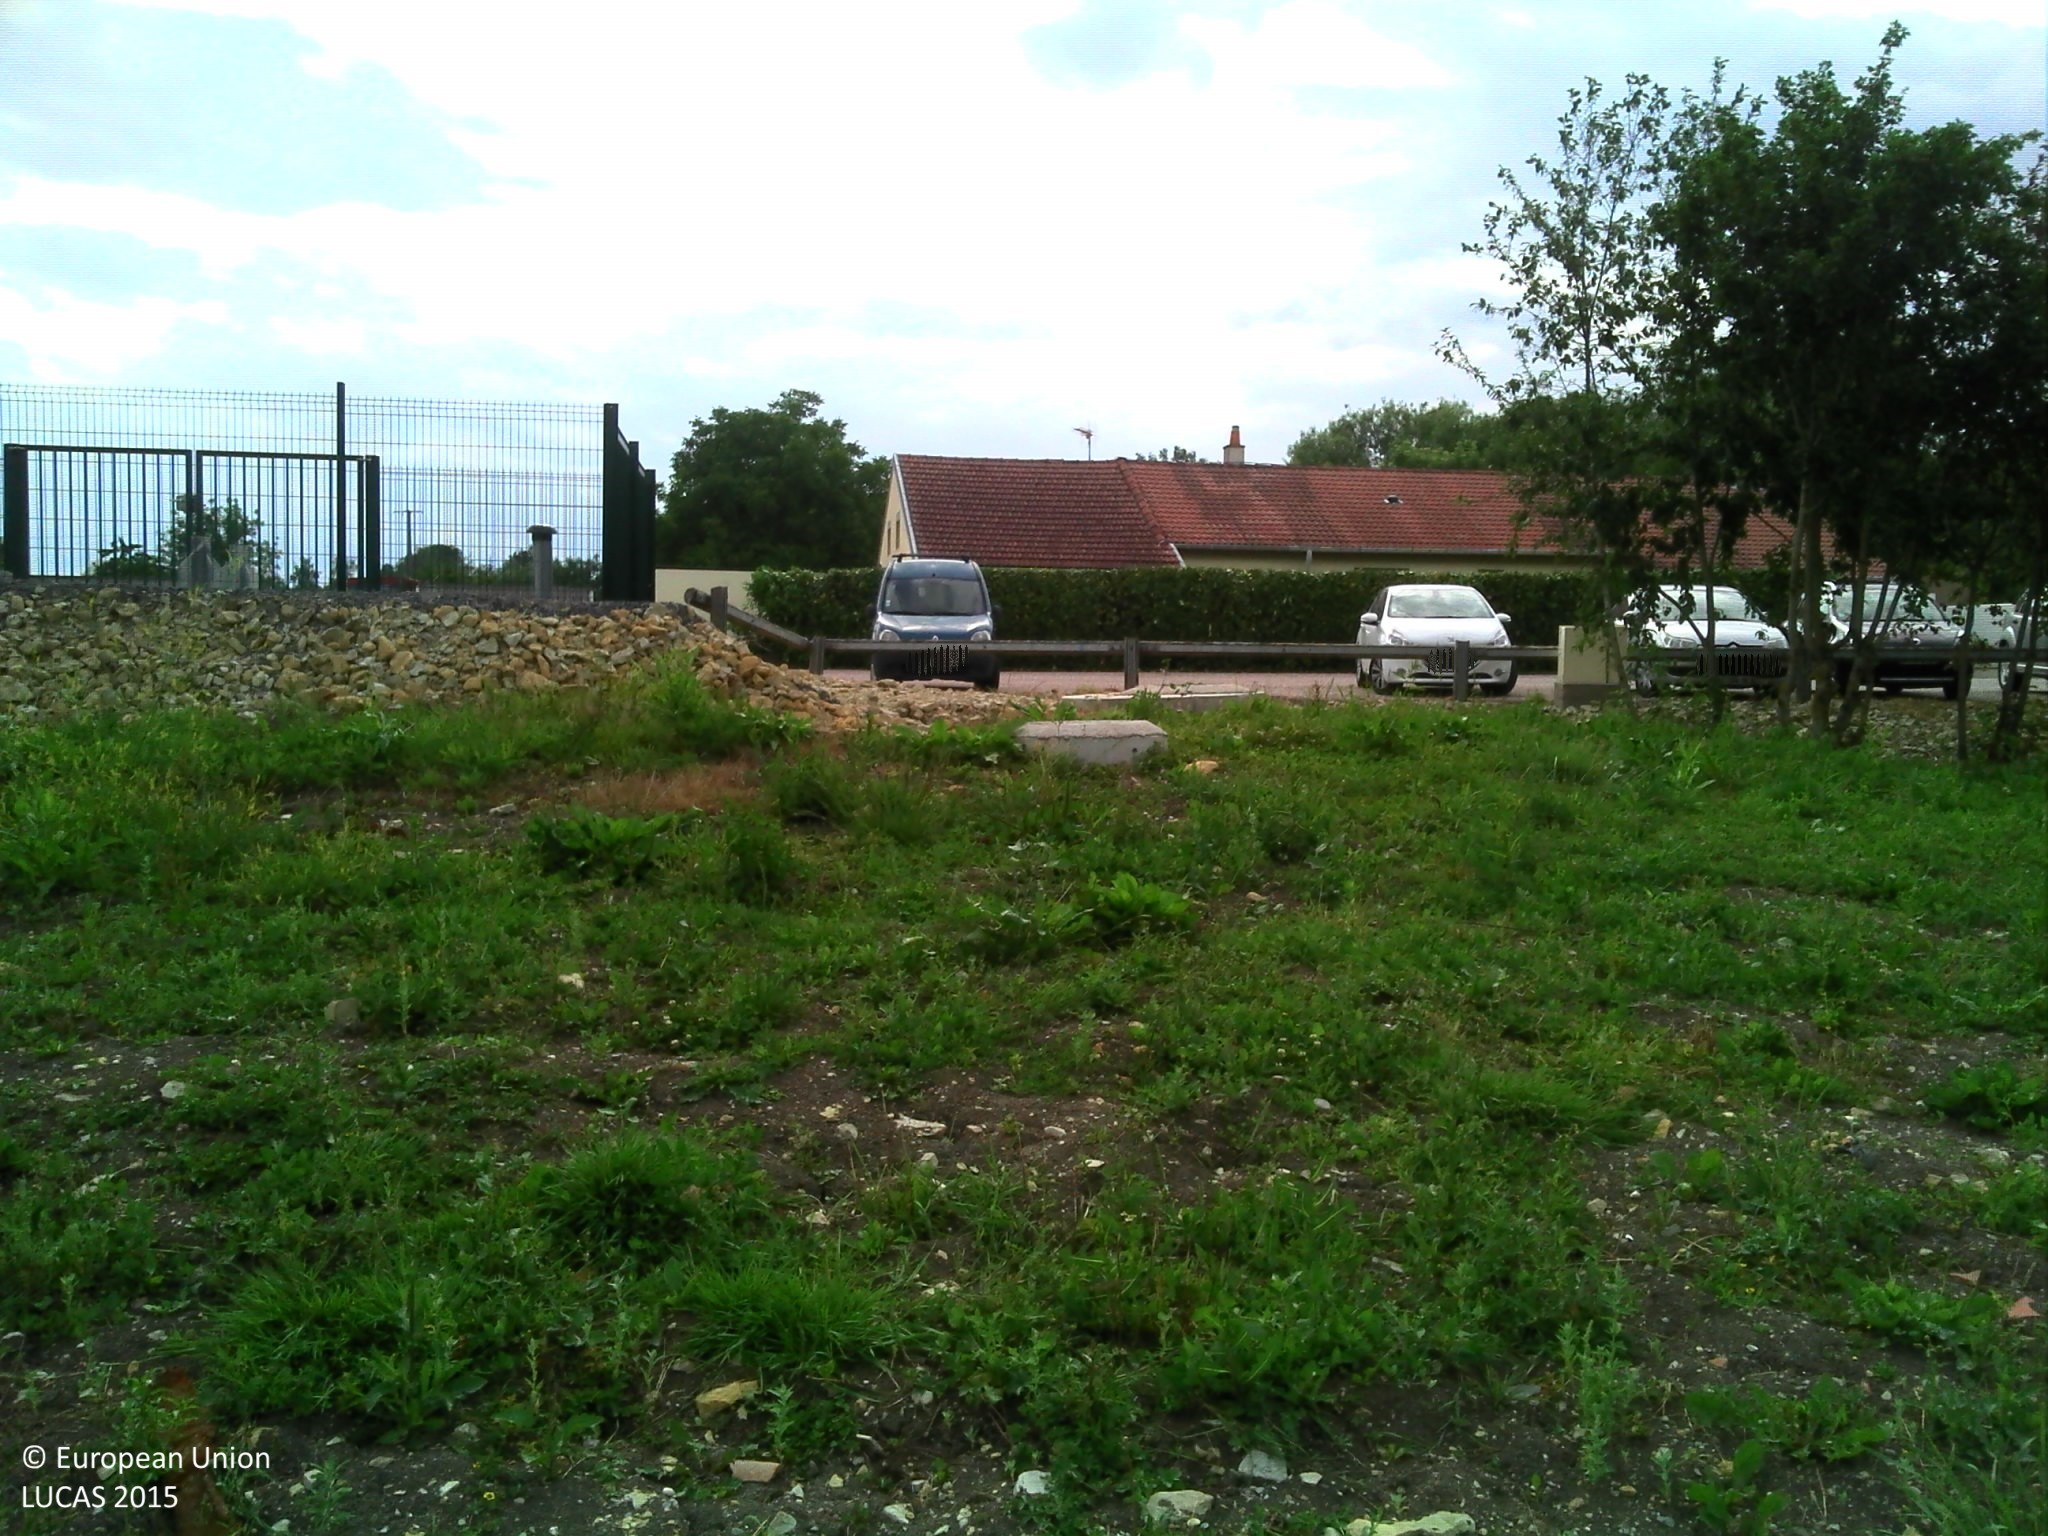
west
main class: Grassland
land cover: Spontaneously vegetated surfaces
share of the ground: > 75 %
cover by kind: herbaceous plants 100 %
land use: Amenities, museums, leisure
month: June
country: FR
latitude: 48.6538
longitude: 6.4844
